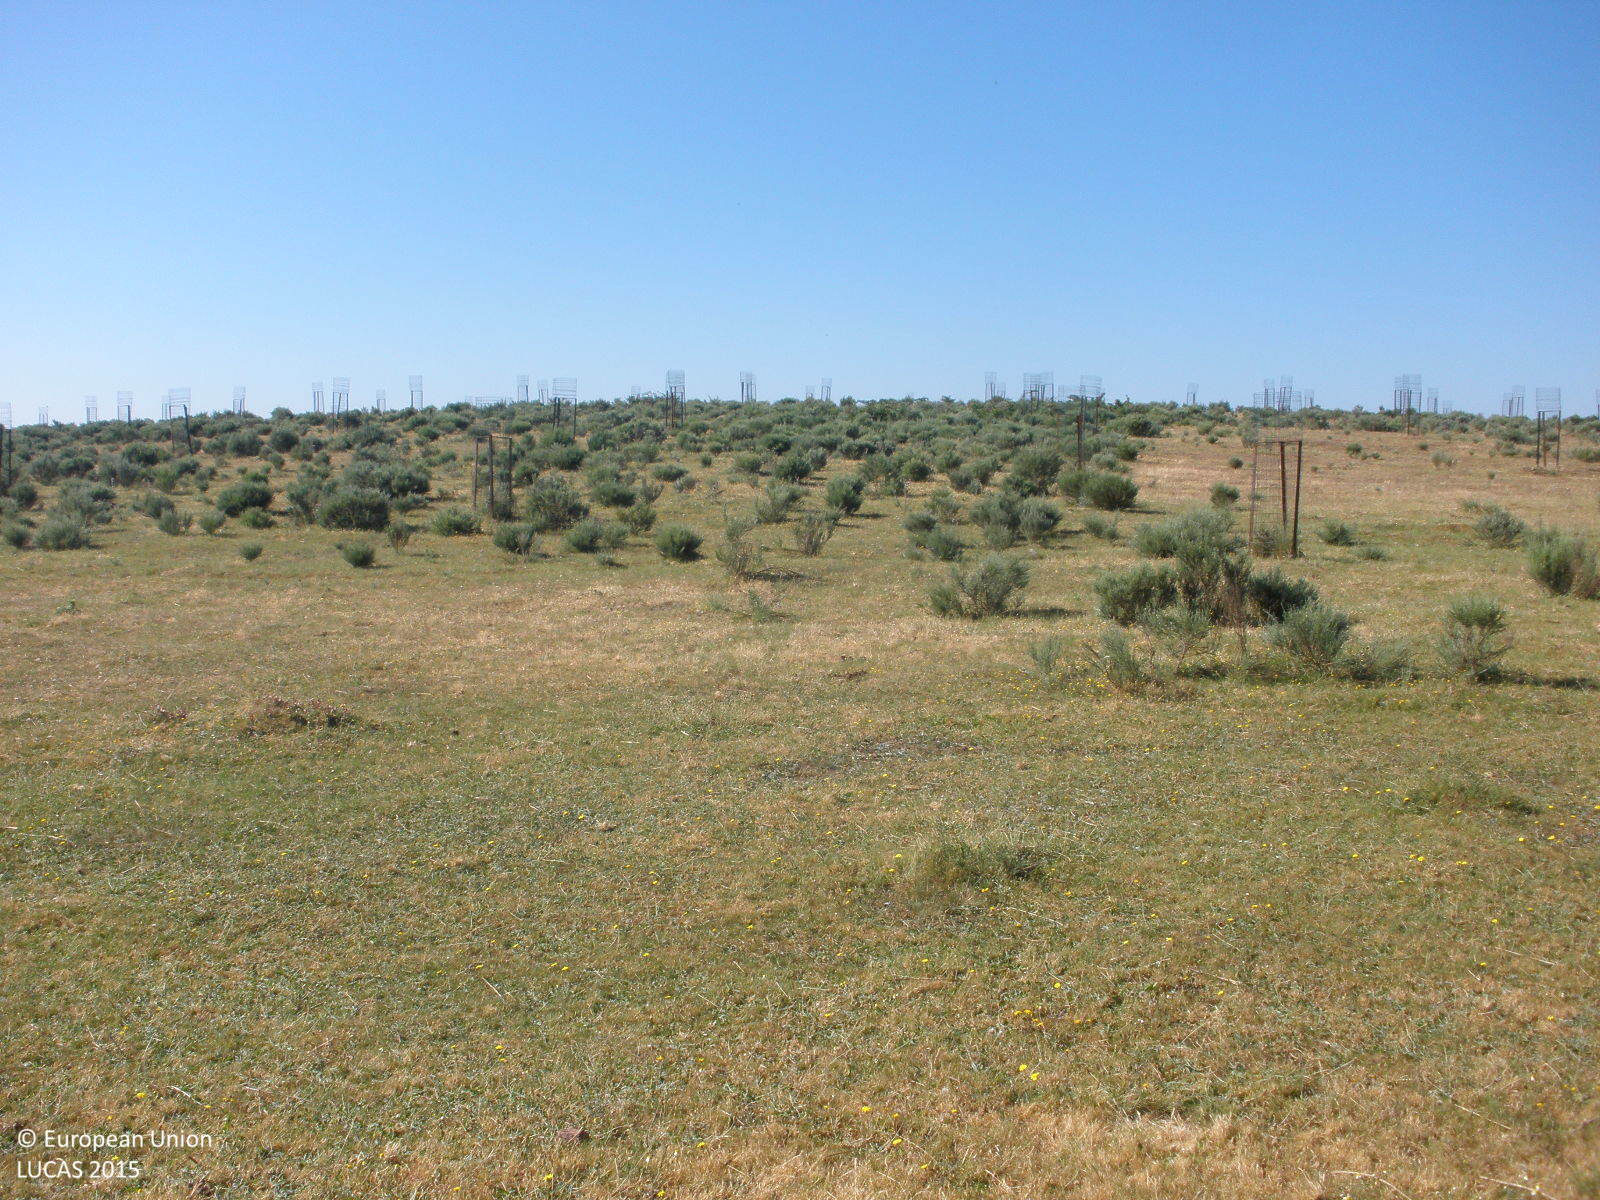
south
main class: Grassland
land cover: Grassland without tree/shrub cover
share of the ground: > 75 %
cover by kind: herbaceous plants 100 %
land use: Agriculture (excluding fallow land and kitchen gardens)
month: June
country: ES
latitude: 40.4356
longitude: -6.6527
